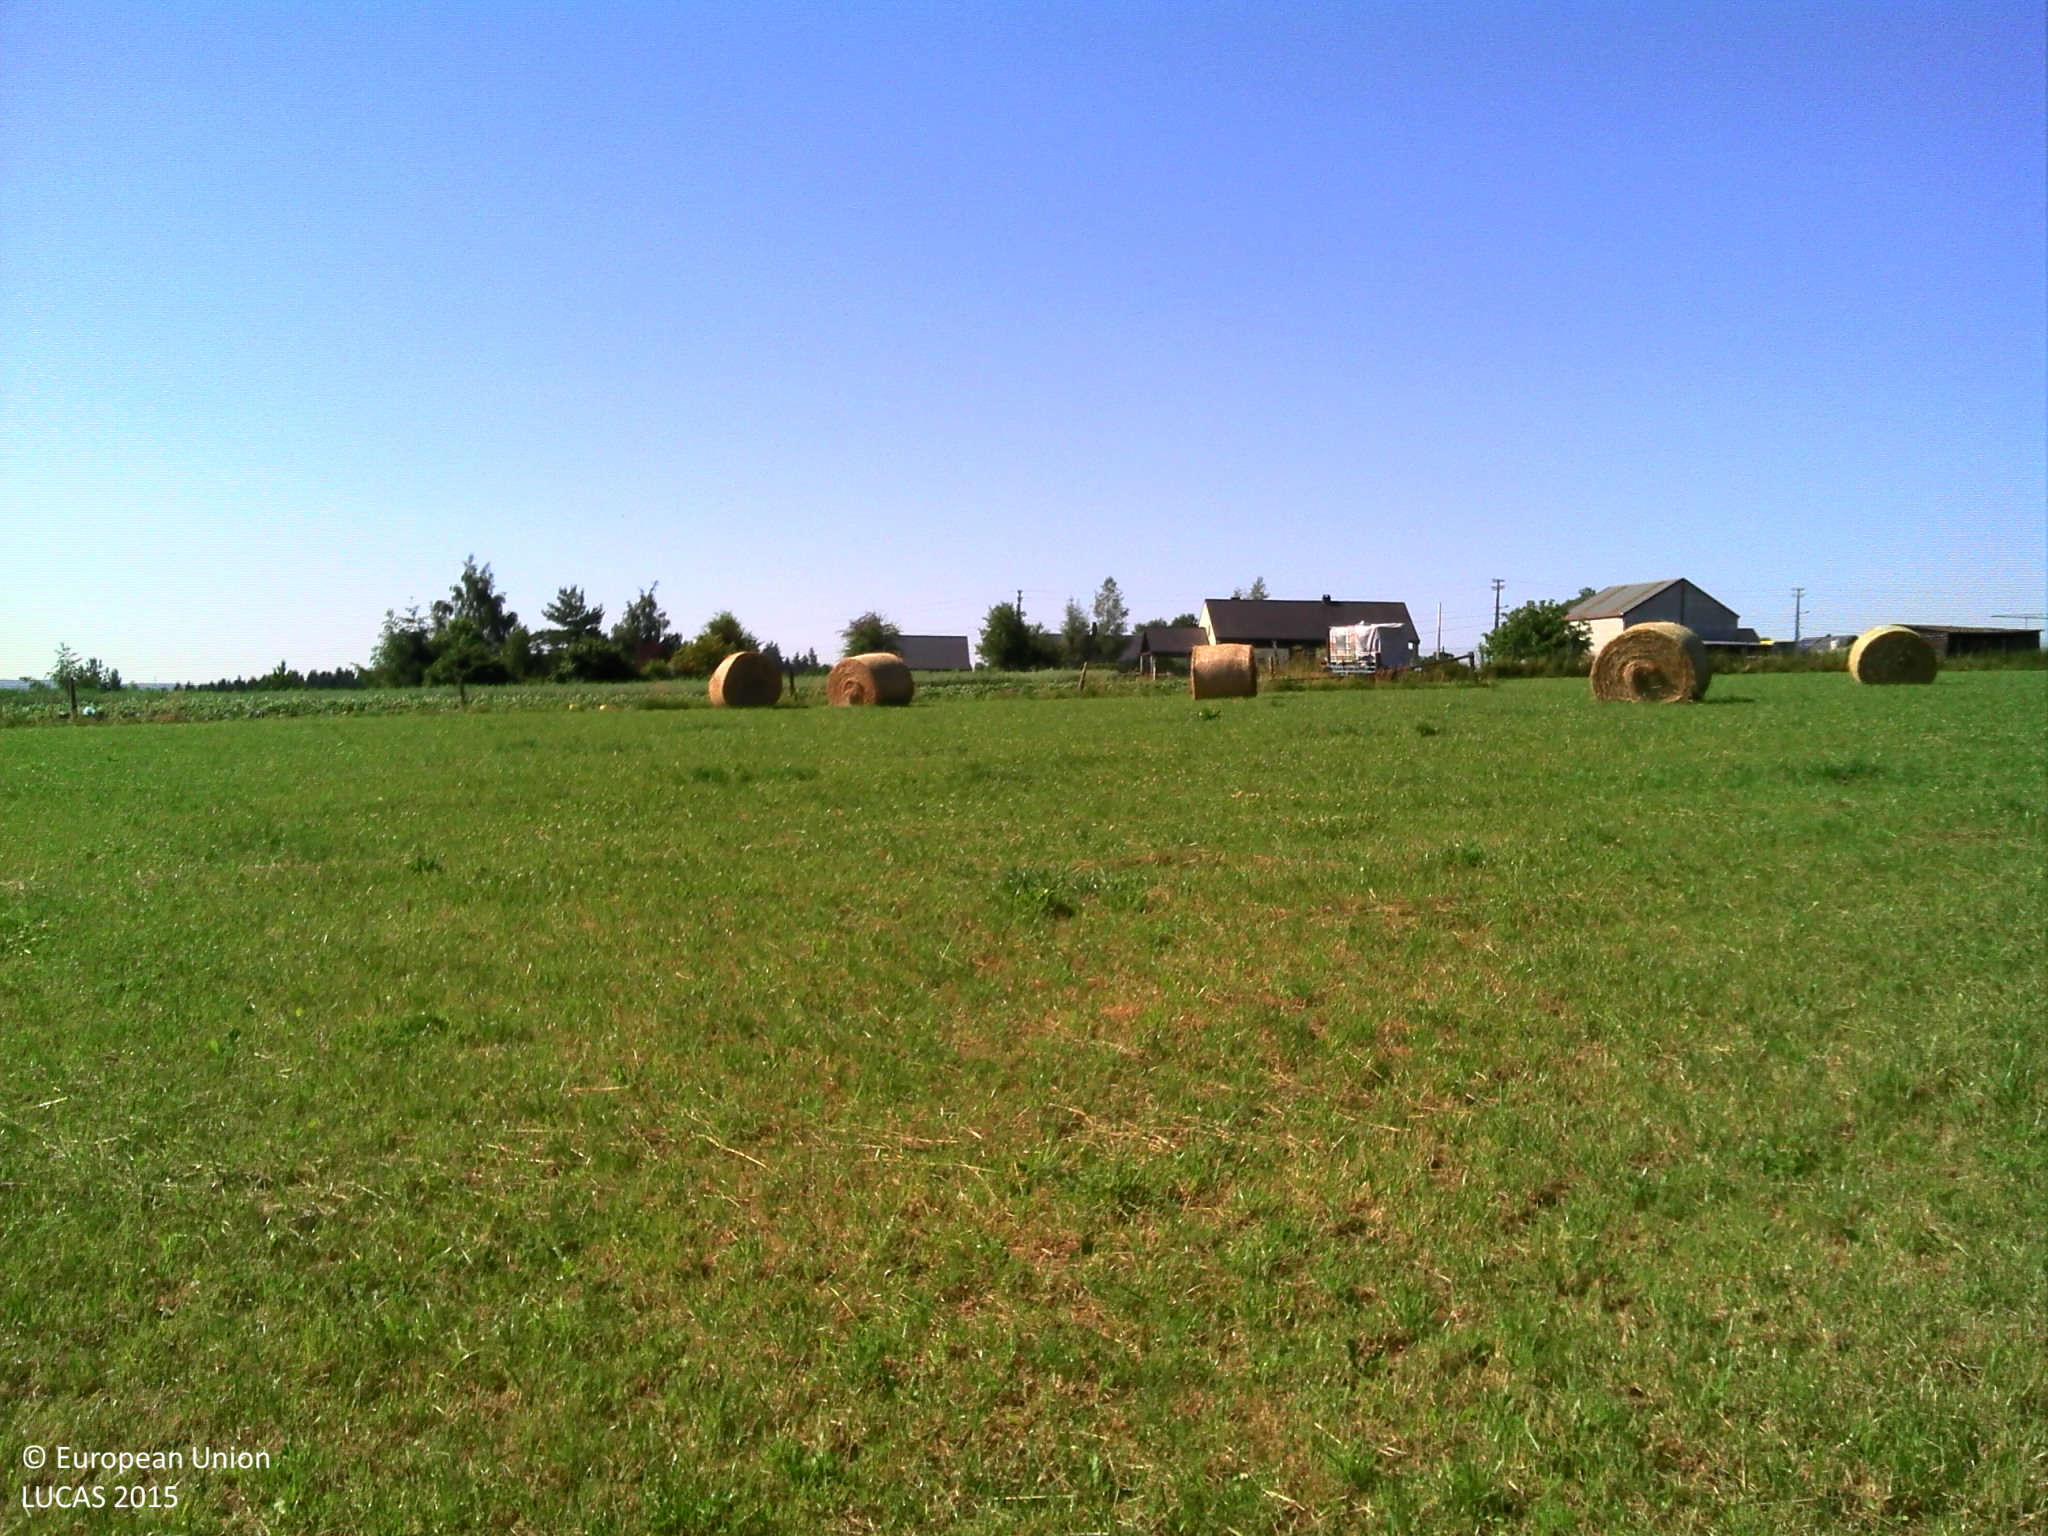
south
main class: Grassland
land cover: Grassland without tree/shrub cover
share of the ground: > 75 %
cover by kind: herbaceous plants 100 %
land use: Agriculture (excluding fallow land and kitchen gardens)
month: July
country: BE
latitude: 50.1604
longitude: 5.7854
